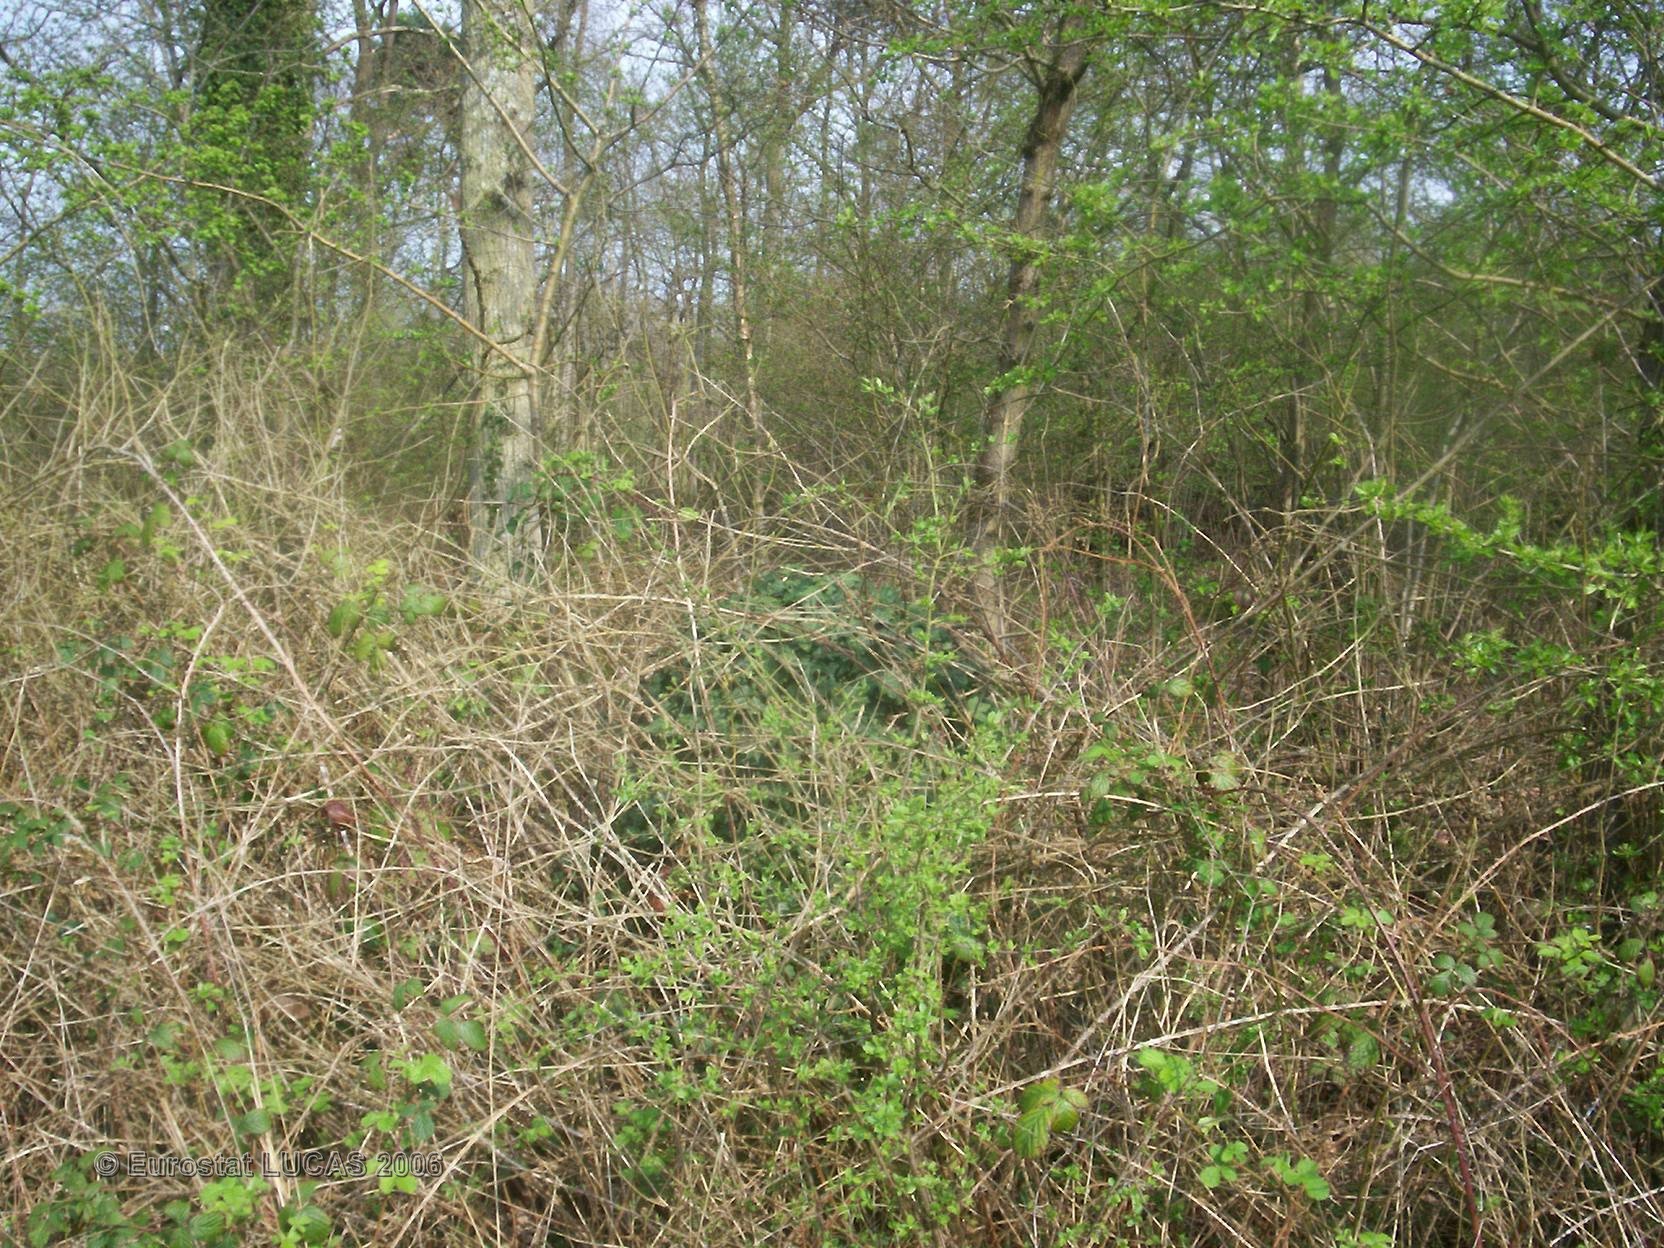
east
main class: Grassland
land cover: Grassland without tree/shrub cover
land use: Agriculture (excluding fallow land and kitchen gardens)
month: April
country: FR
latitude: 49.1003
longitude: -0.0988
